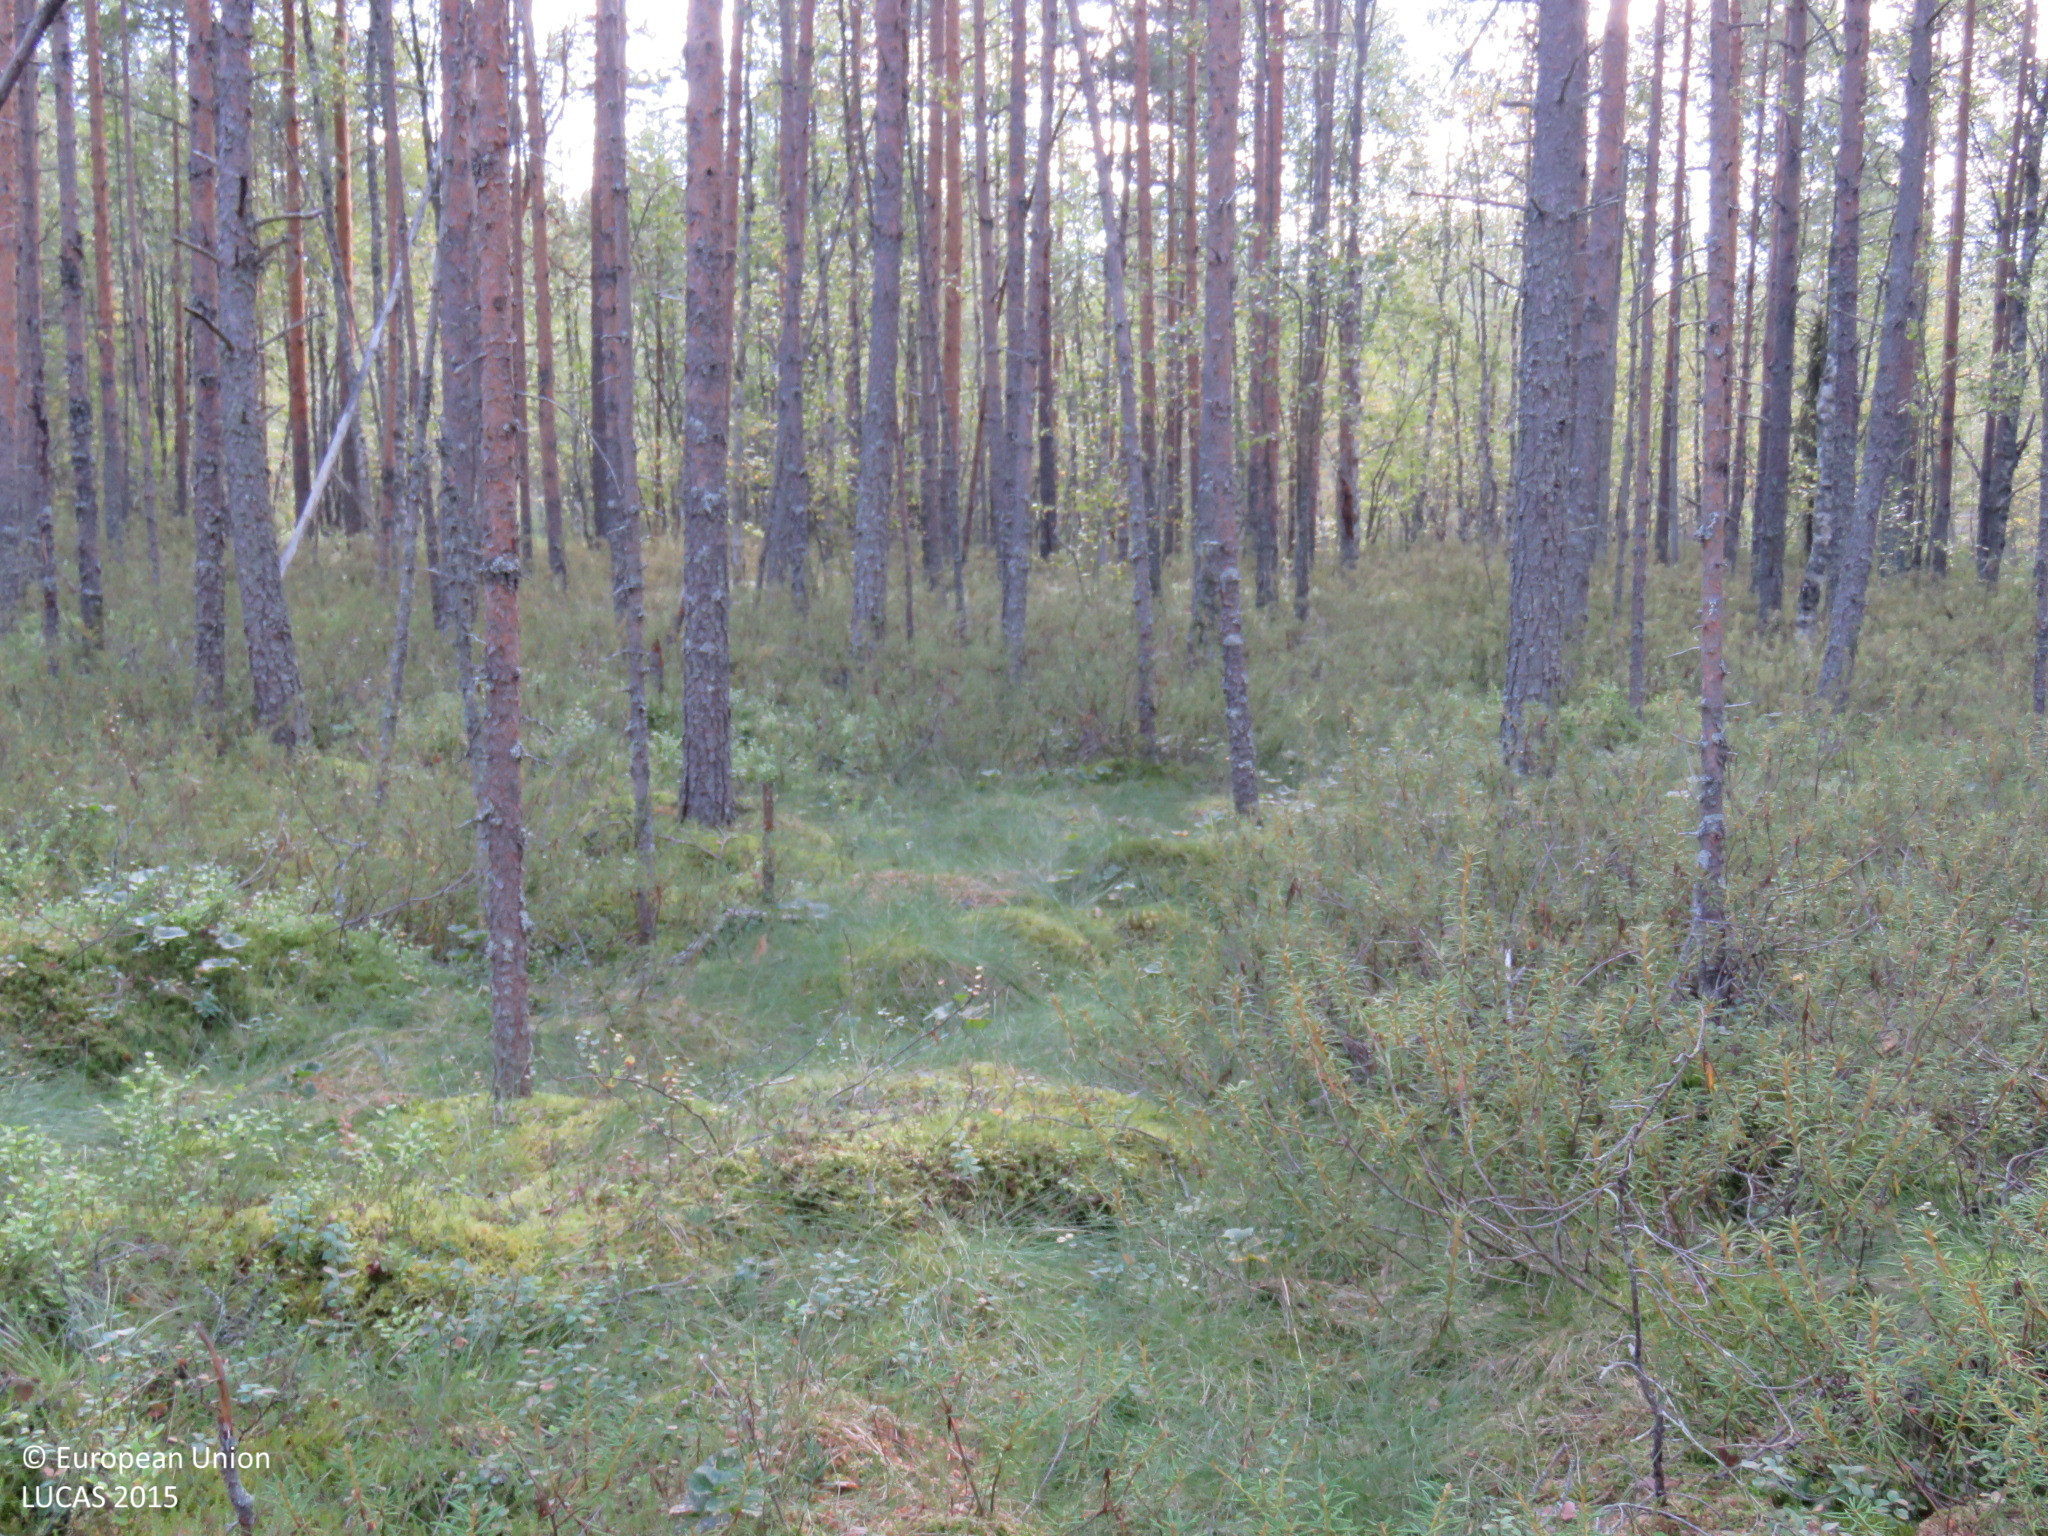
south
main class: Woodland
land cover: Pine dominated coniferous woodland
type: mire and swamp forests
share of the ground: > 75 %
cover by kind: coniferous forest trees 70 %, shrubs 20 %, broadleaved forest trees 5 %, lichens and mosses 5 %
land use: Forestry
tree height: > 5 m
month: August
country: FI
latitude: 65.1480
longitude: 25.6742
